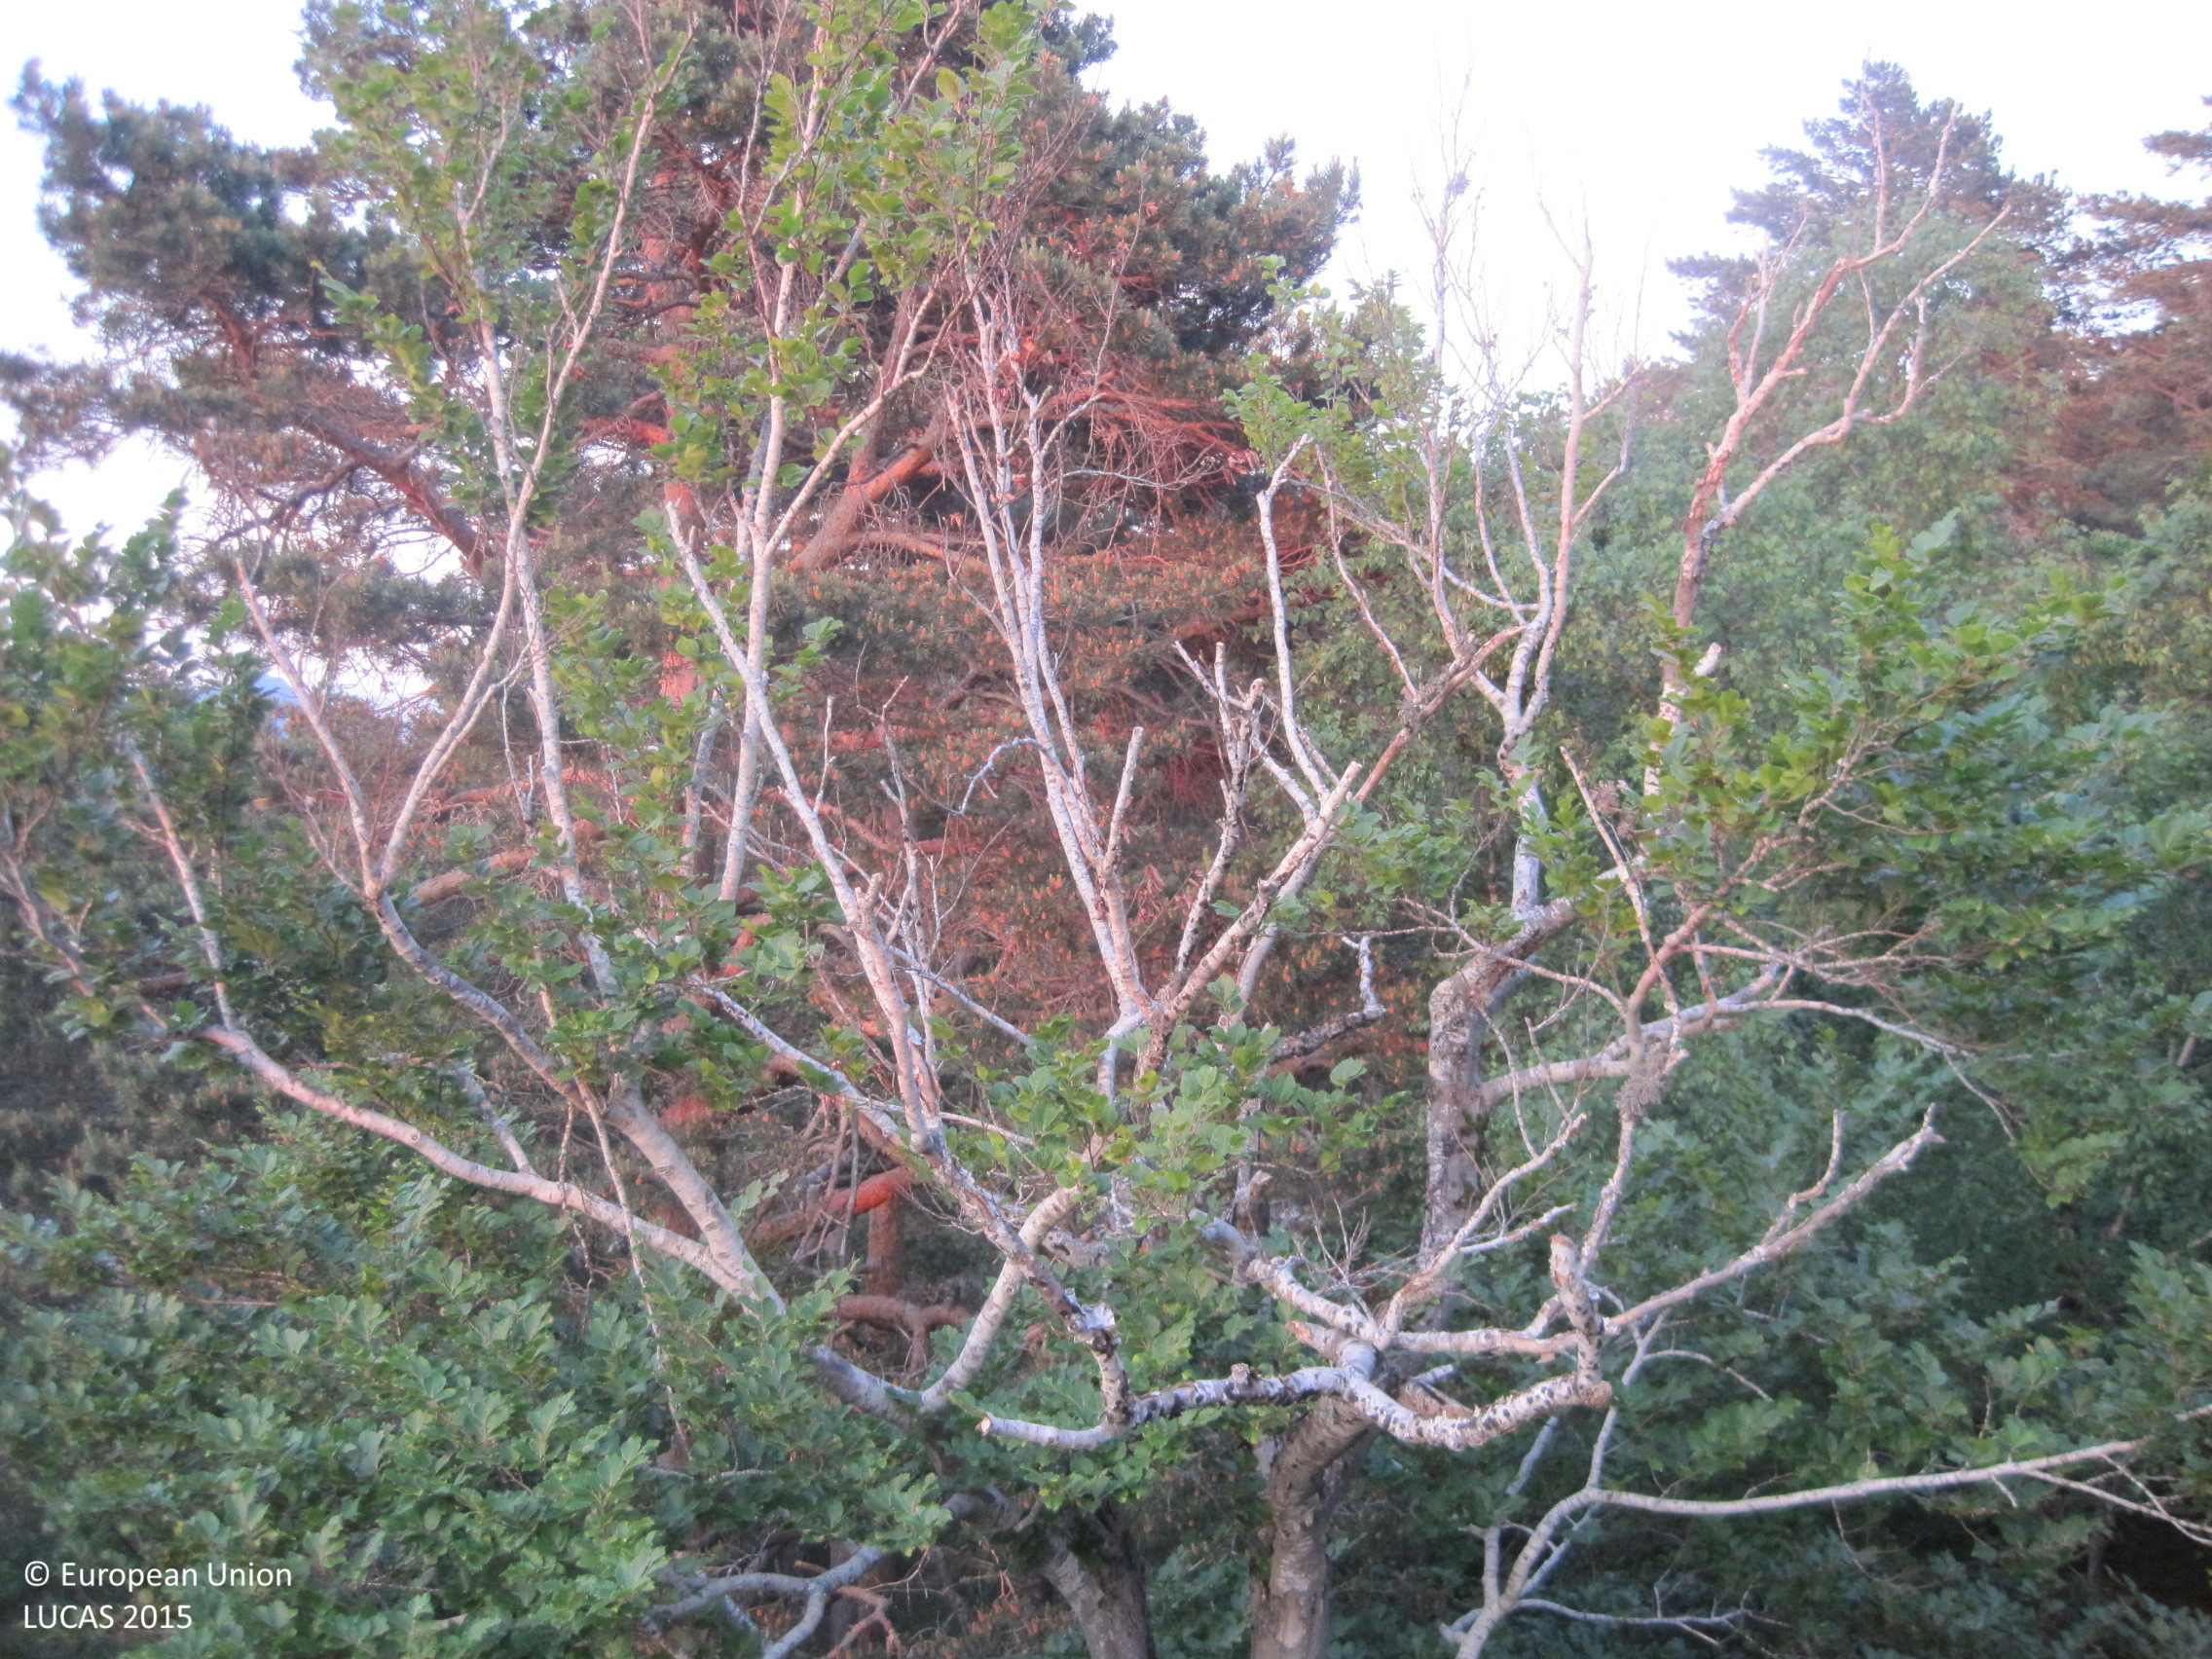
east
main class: Woodland
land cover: Pine dominated coniferous woodland
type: coniferous forest of the mediterranean region
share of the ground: > 75 %
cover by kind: coniferous forest trees 75 %, broadleaved forest trees 15 %, consolidated bare surface 10 %
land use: Forestry
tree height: > 5 m
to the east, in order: Pine dominated coniferous woodland
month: June
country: ES
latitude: 42.6561
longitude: -1.1461
